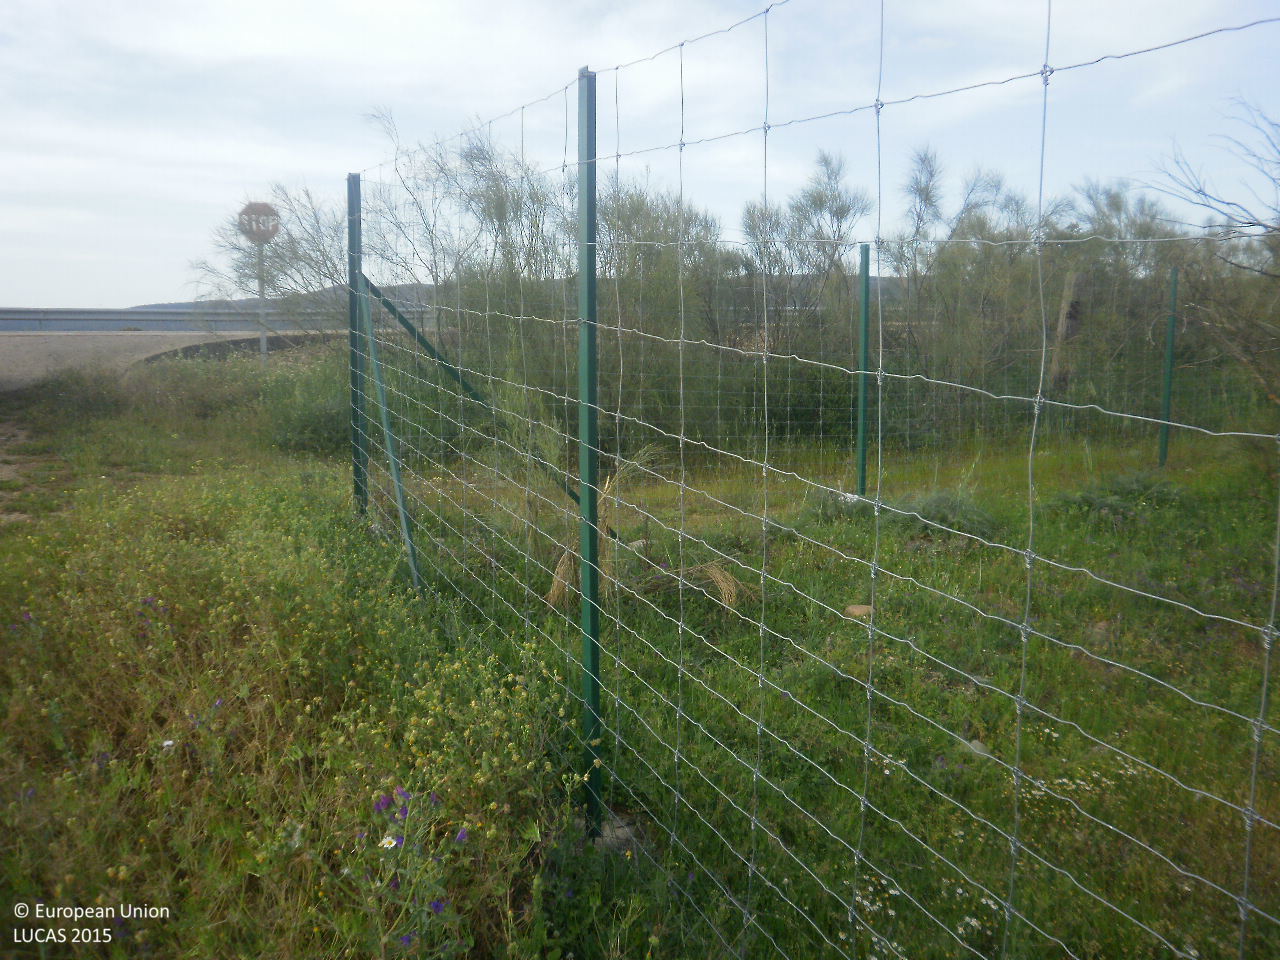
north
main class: Woodland
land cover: Broadleaved woodland
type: broadleaved evergreen forest
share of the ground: 50 - 75 %
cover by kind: broadleaved forest trees 50 %, shrubs 35 %, herbaceous plants 15 %
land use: Agriculture (excluding fallow land and kitchen gardens)
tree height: > 5 m
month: April
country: ES
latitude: 39.1185
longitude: -5.2744
